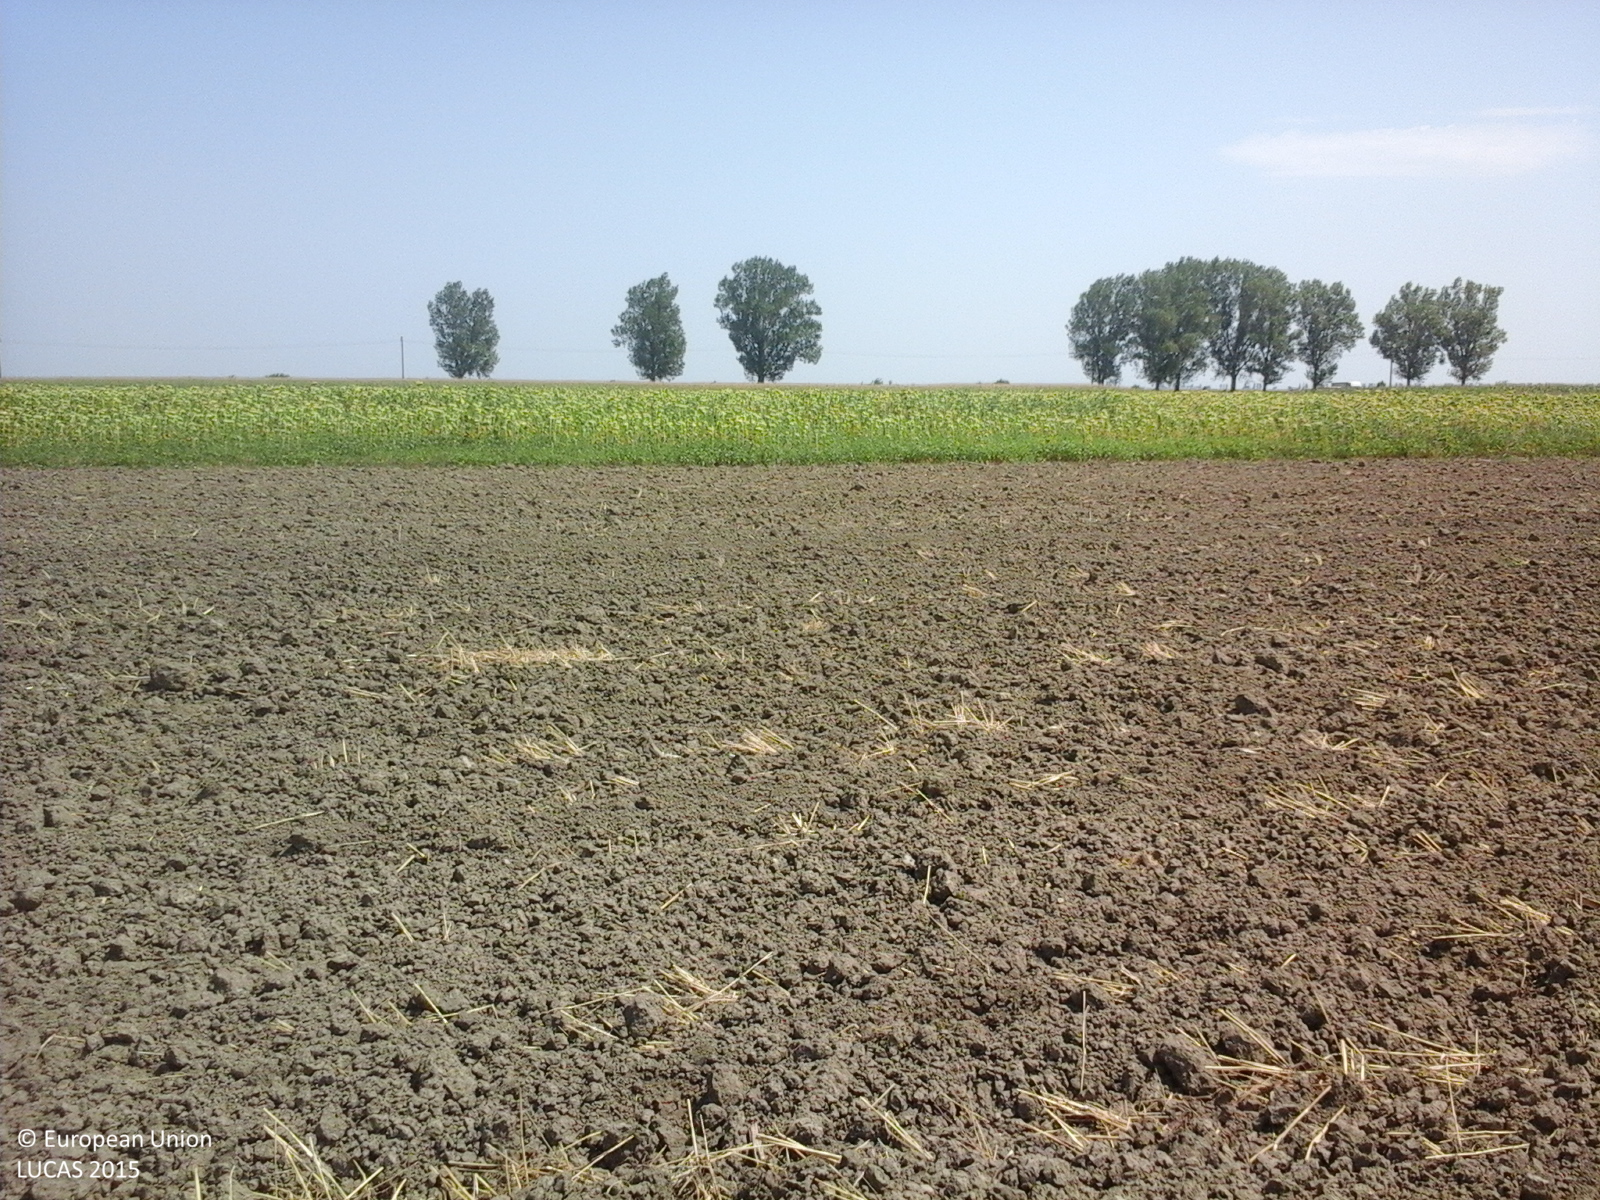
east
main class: Cropland
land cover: Barley
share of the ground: 25 - 50 %
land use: Agriculture (excluding fallow land and kitchen gardens)
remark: Harvested field
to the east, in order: Barley; Sunflower; Common wheat; Sunflower; Common wheat; Grass margins; Mixed cereals for fodder; Lucerne; Grassland without tree/shrub cover; Sunflower; Grassland without tree/shrub cover; Sunflower; Mixed cereals for fodder; Grass margins; Maize
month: August
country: RO
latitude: 45.3338
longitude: 27.7295
